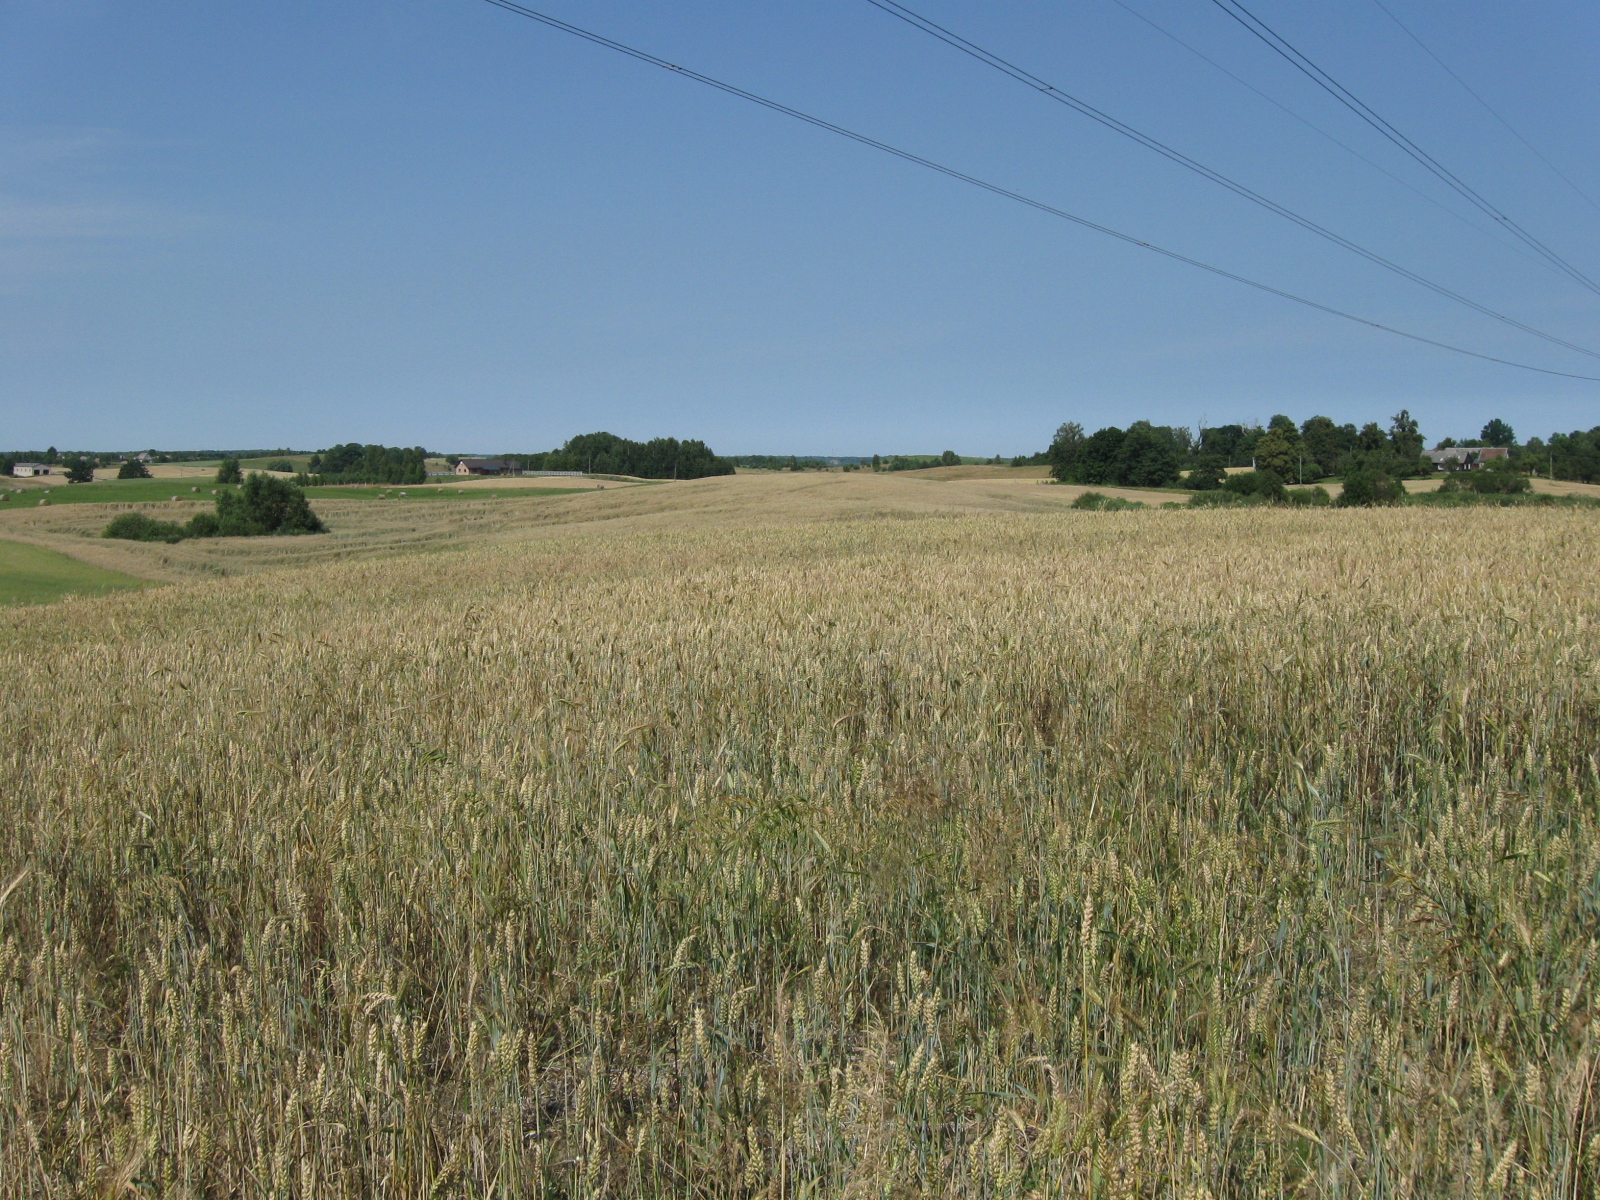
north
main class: Cropland
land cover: Common wheat
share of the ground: > 75 %
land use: Agriculture (excluding fallow land and kitchen gardens)
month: July
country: LT
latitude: 54.6761
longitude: 23.9075
